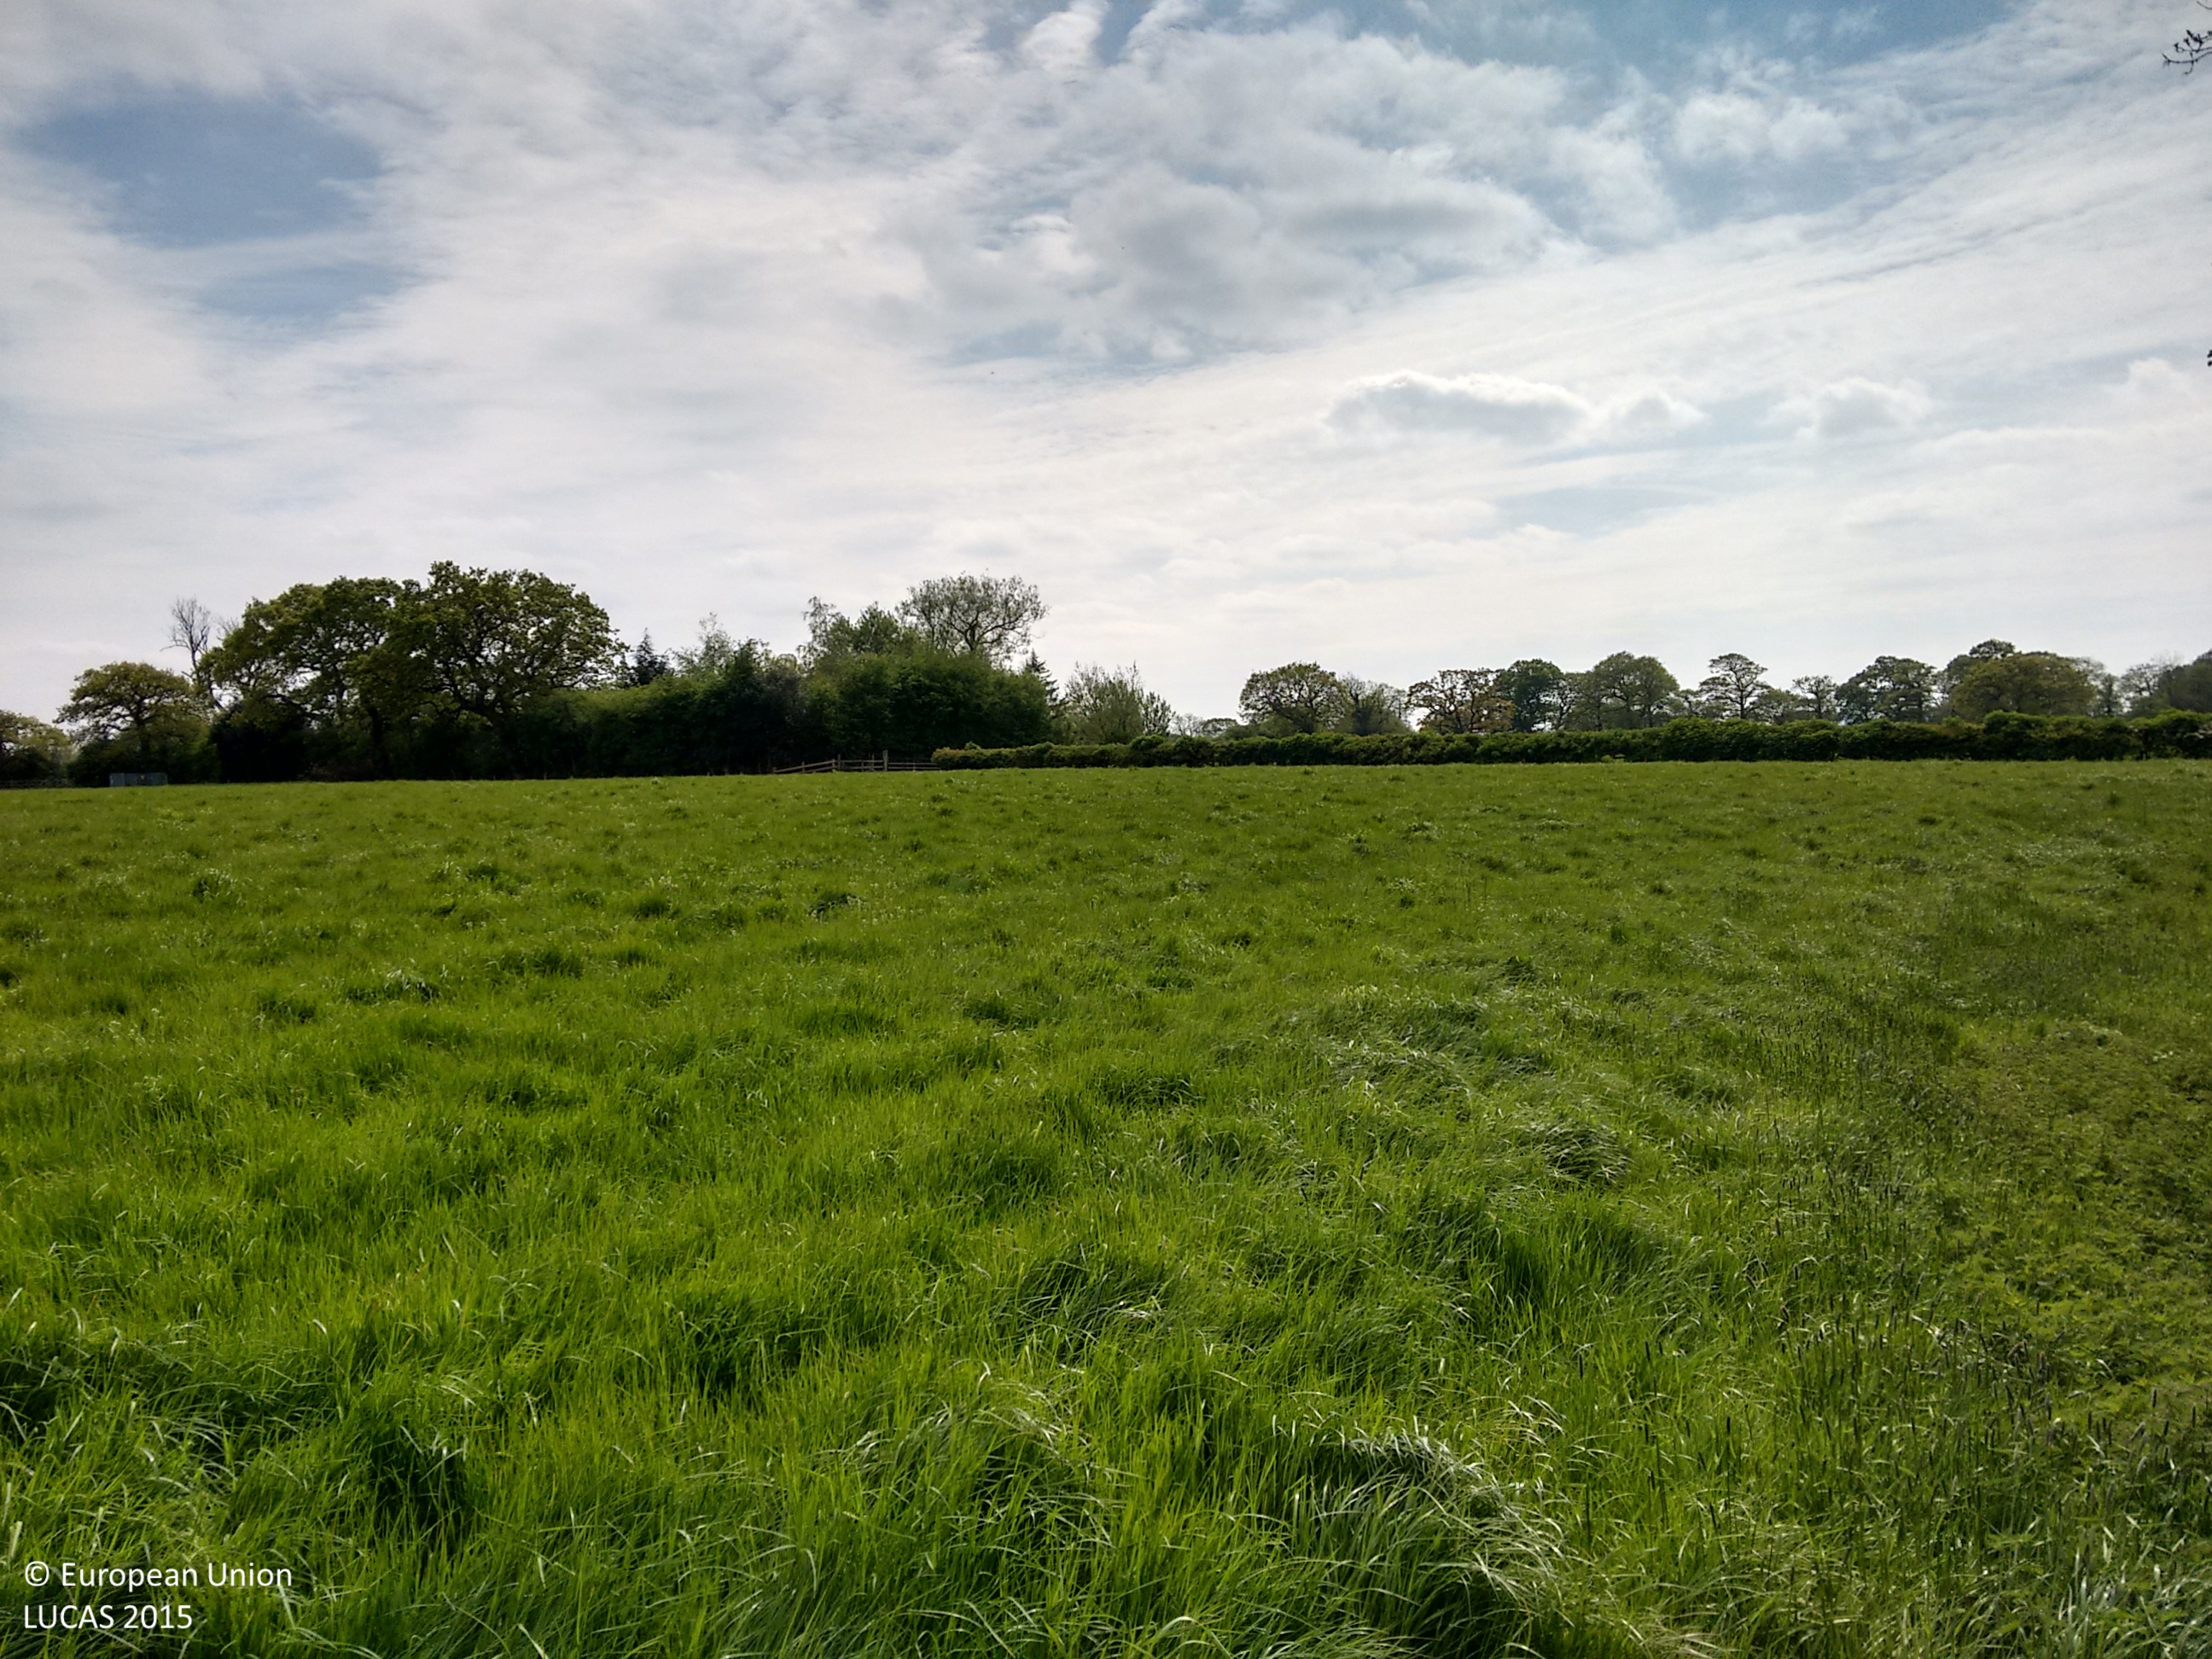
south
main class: Grassland
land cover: Grassland without tree/shrub cover
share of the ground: > 75 %
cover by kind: herbaceous plants 100 %
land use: Agriculture (excluding fallow land and kitchen gardens)
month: May
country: GB
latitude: 53.7559
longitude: -2.6409
